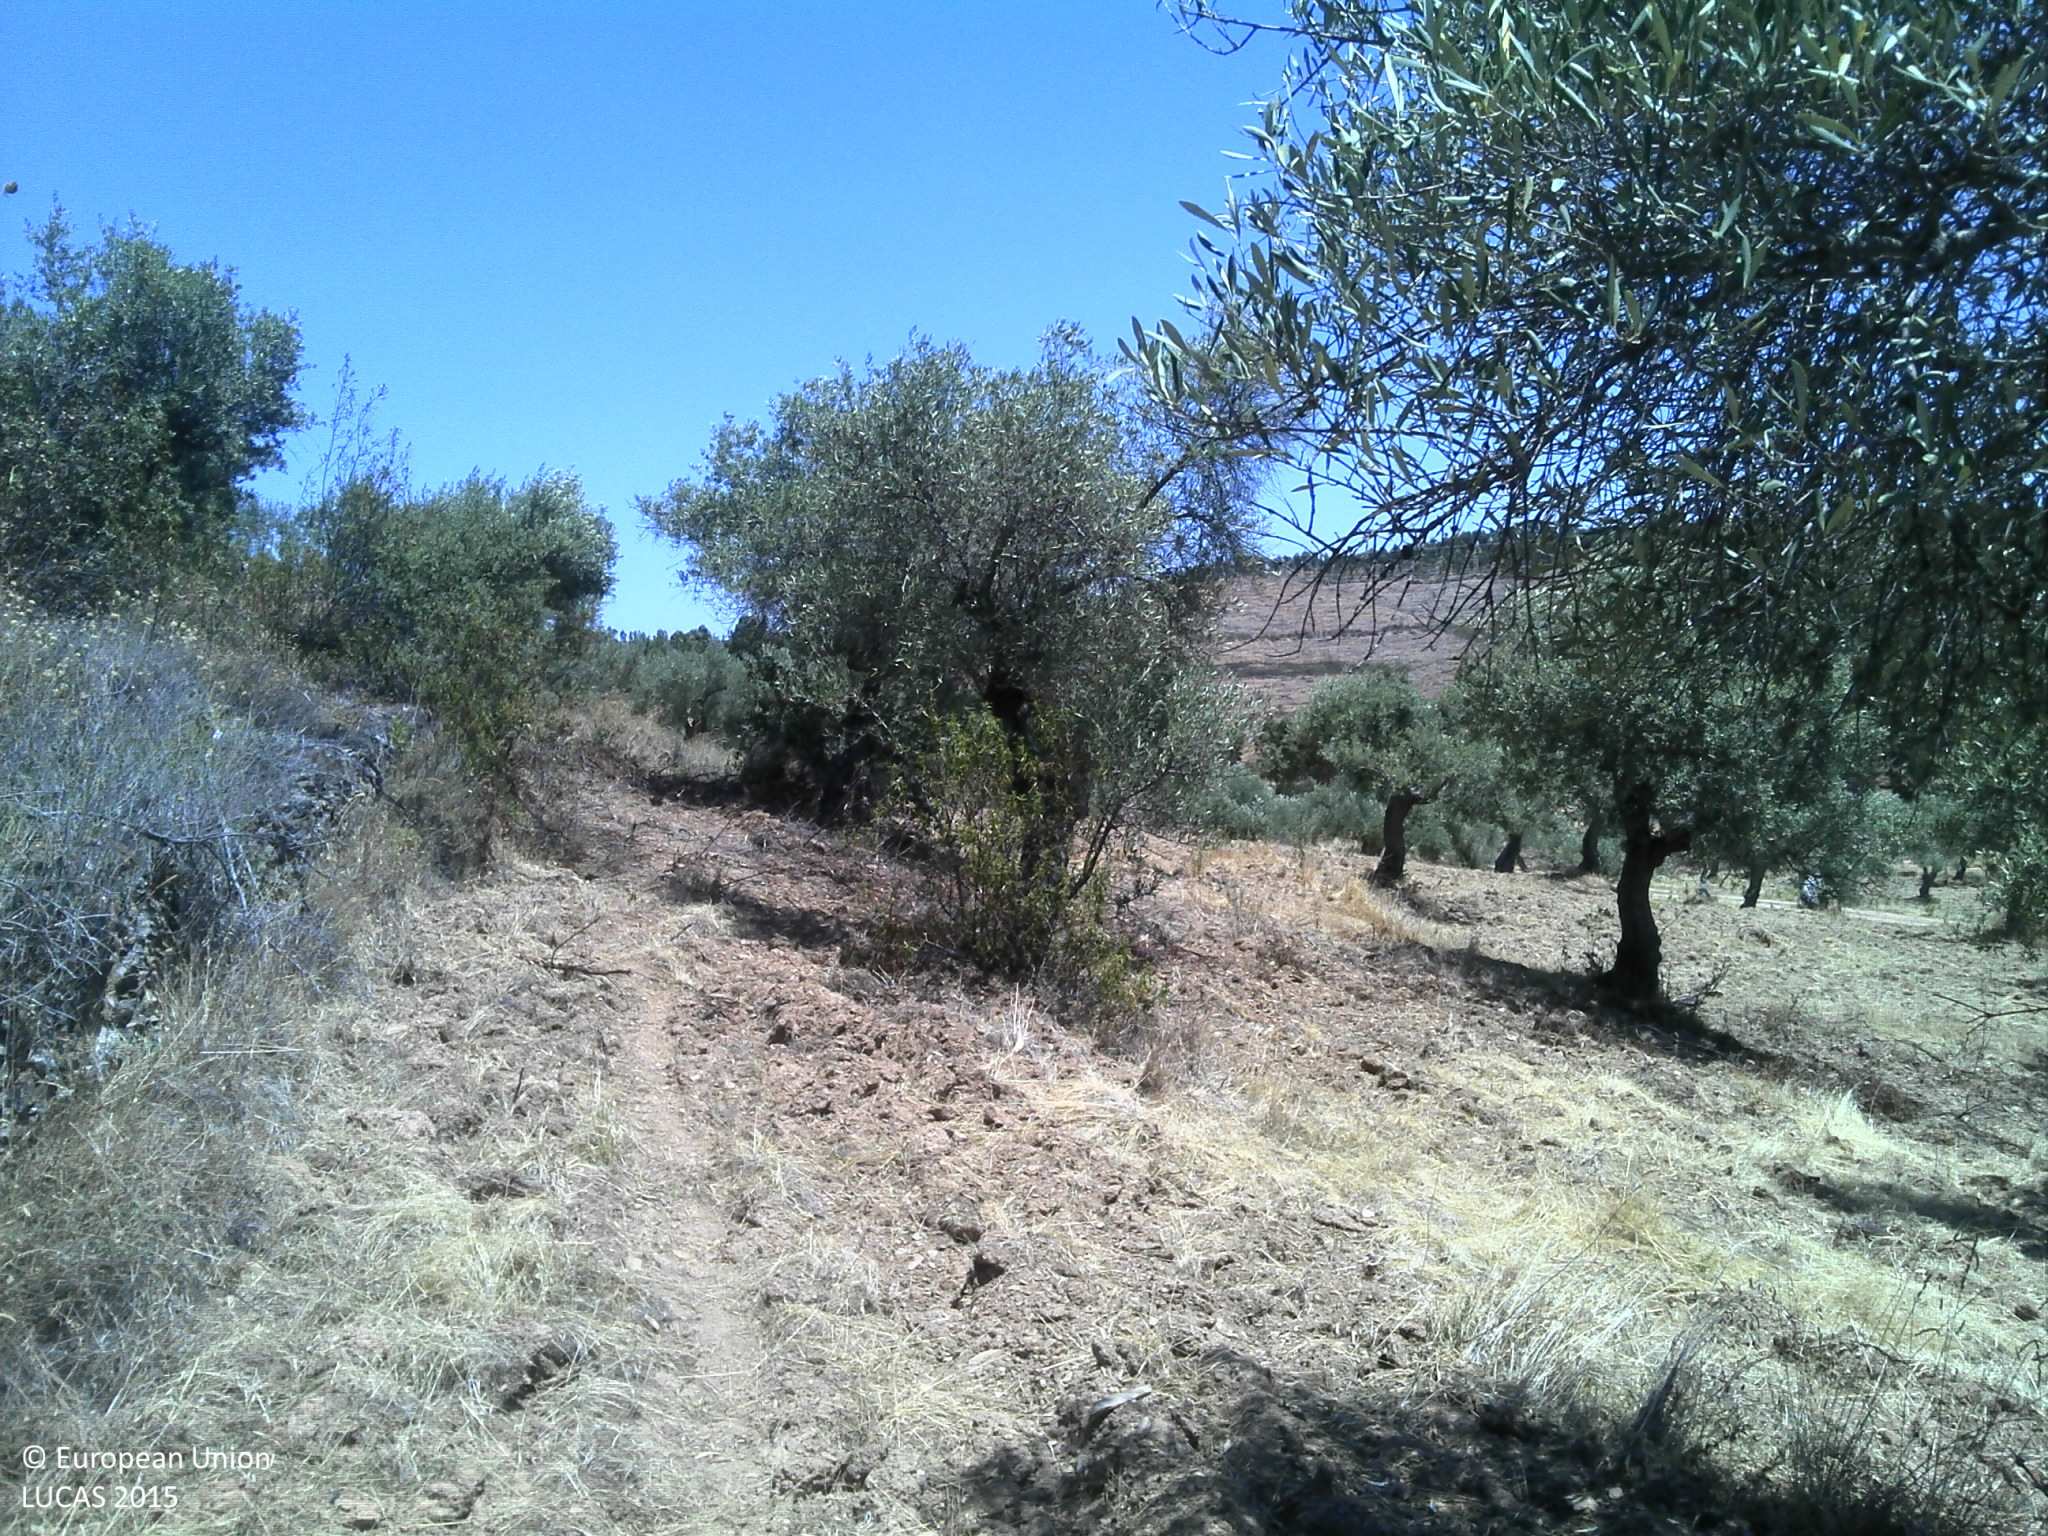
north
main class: Cropland
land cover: Olive groves
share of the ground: 25 - 50 %
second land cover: Shrubland without tree cover
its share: 25 - 50 %
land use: Agriculture (excluding fallow land and kitchen gardens)
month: July
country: PT
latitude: 39.7431
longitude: -7.5450
